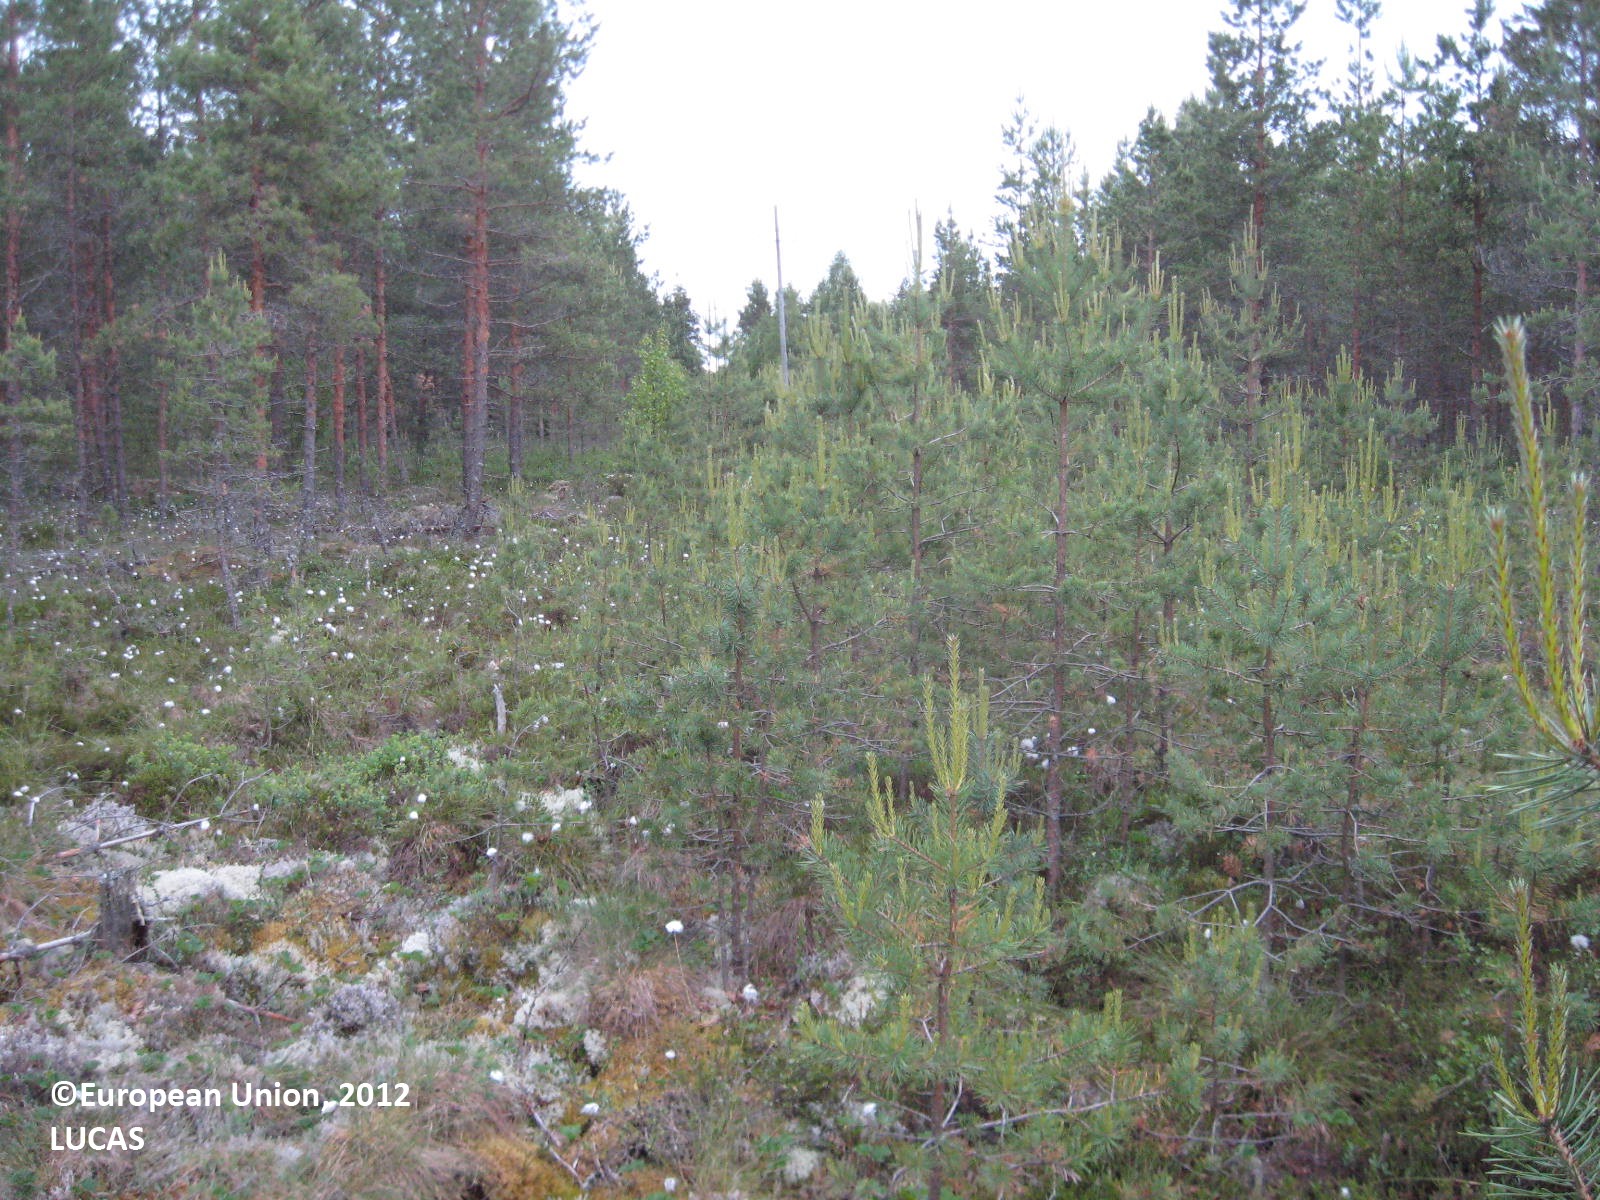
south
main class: Woodland
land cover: Pine dominated coniferous woodland
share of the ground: > 75 %
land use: Forestry
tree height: < 5 m
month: June
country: FI
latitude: 62.8987
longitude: 22.6668
